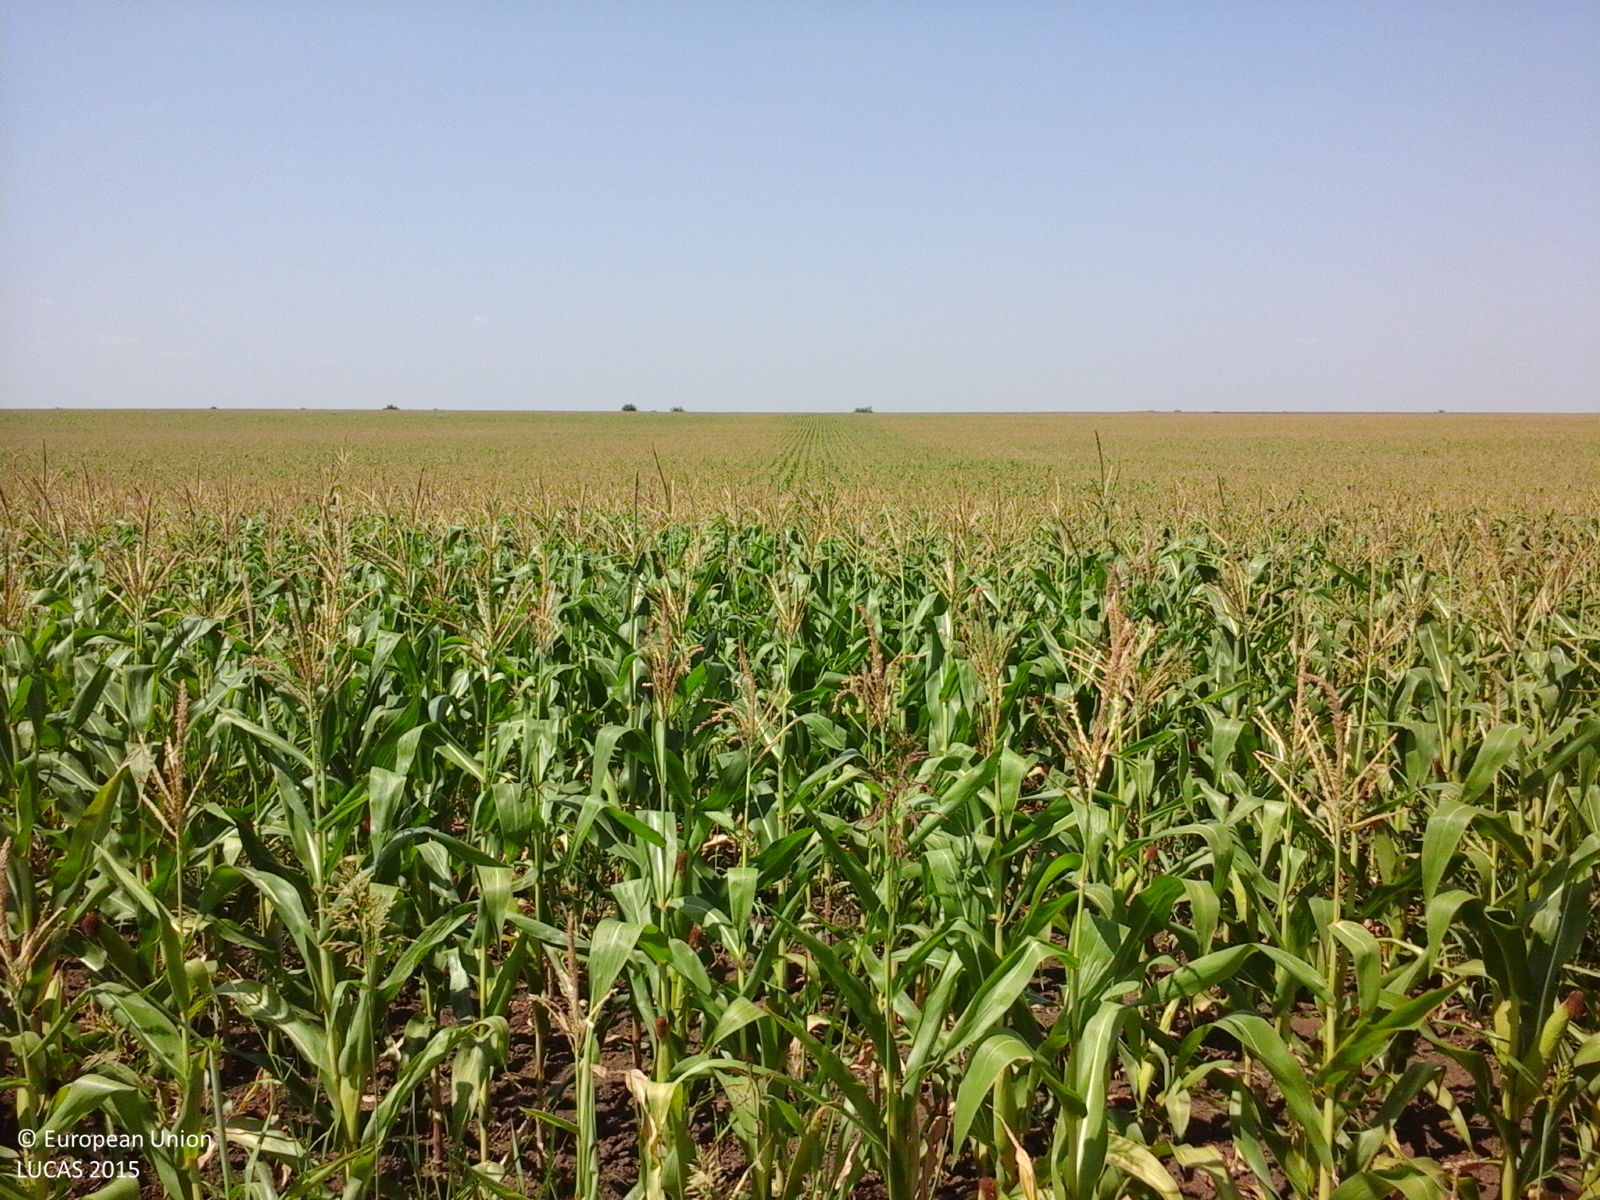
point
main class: Cropland
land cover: Maize
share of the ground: > 75 %
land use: Agriculture (excluding fallow land and kitchen gardens)
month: July
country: RO
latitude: 44.2738
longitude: 27.0283
